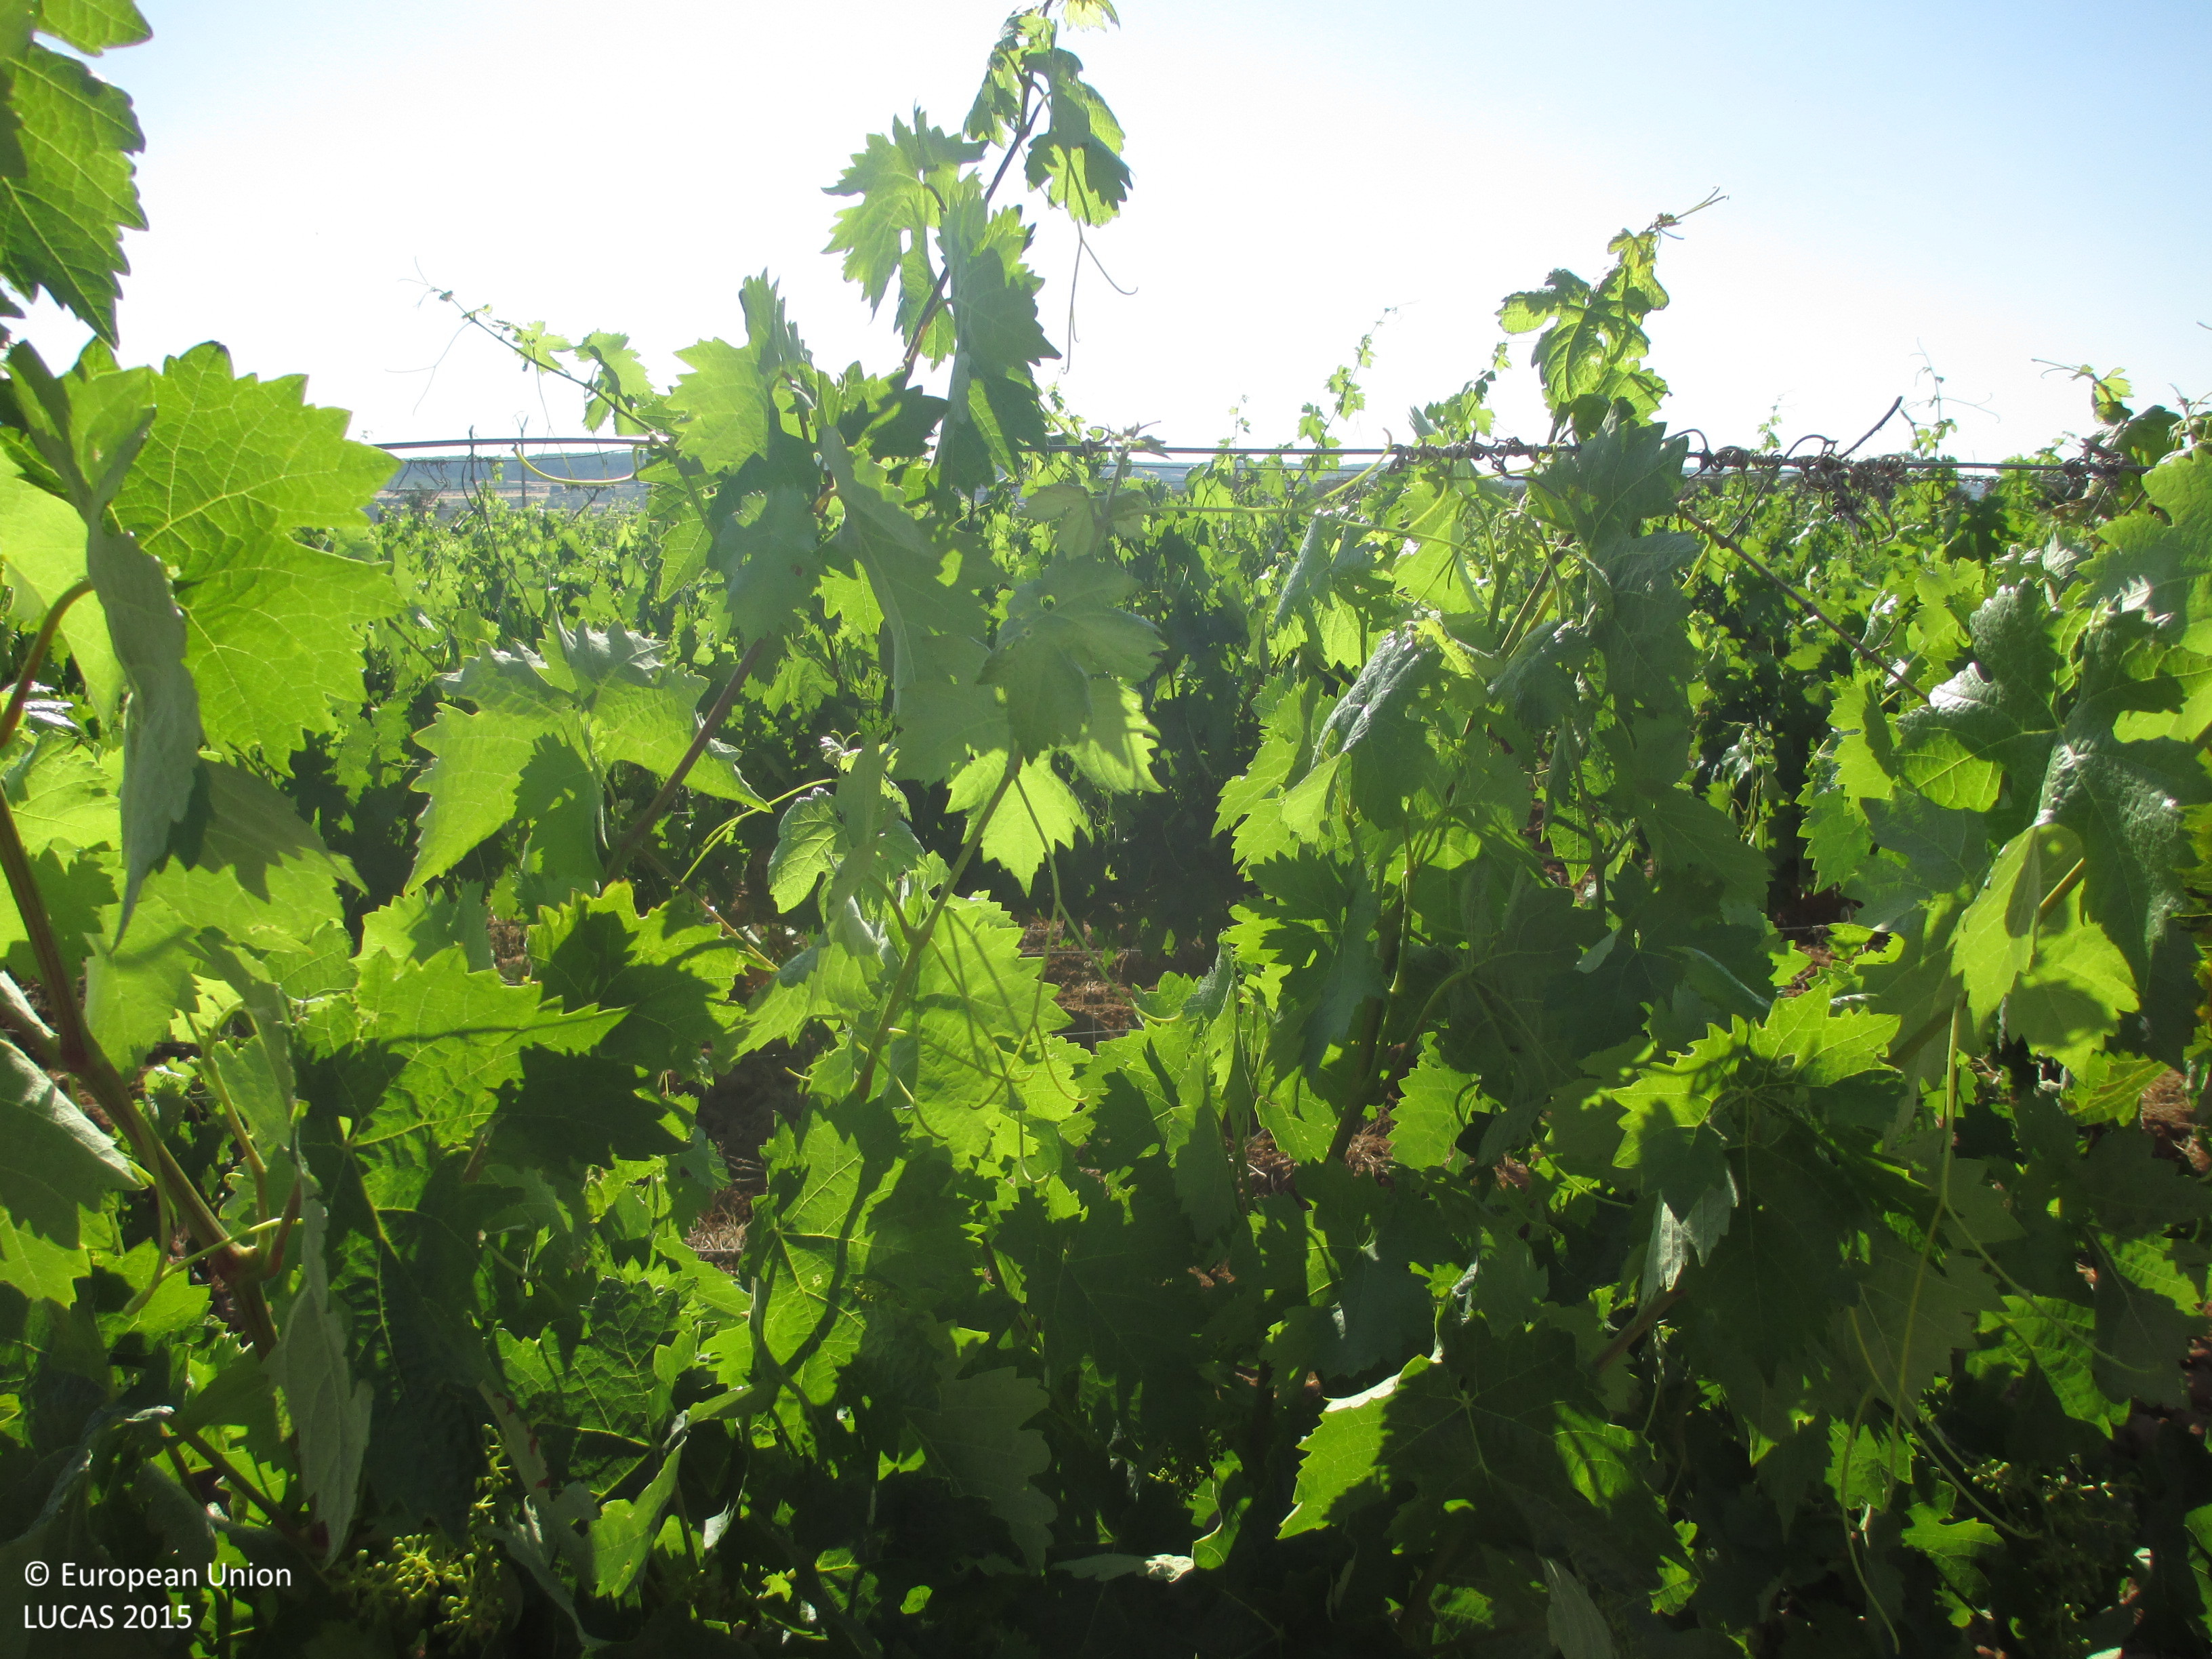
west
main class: Cropland
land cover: Vineyards
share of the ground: > 75 %
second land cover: Other bare soil
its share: > 75 %
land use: Agriculture (excluding fallow land and kitchen gardens)
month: June
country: ES
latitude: 42.0883
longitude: 0.0311
